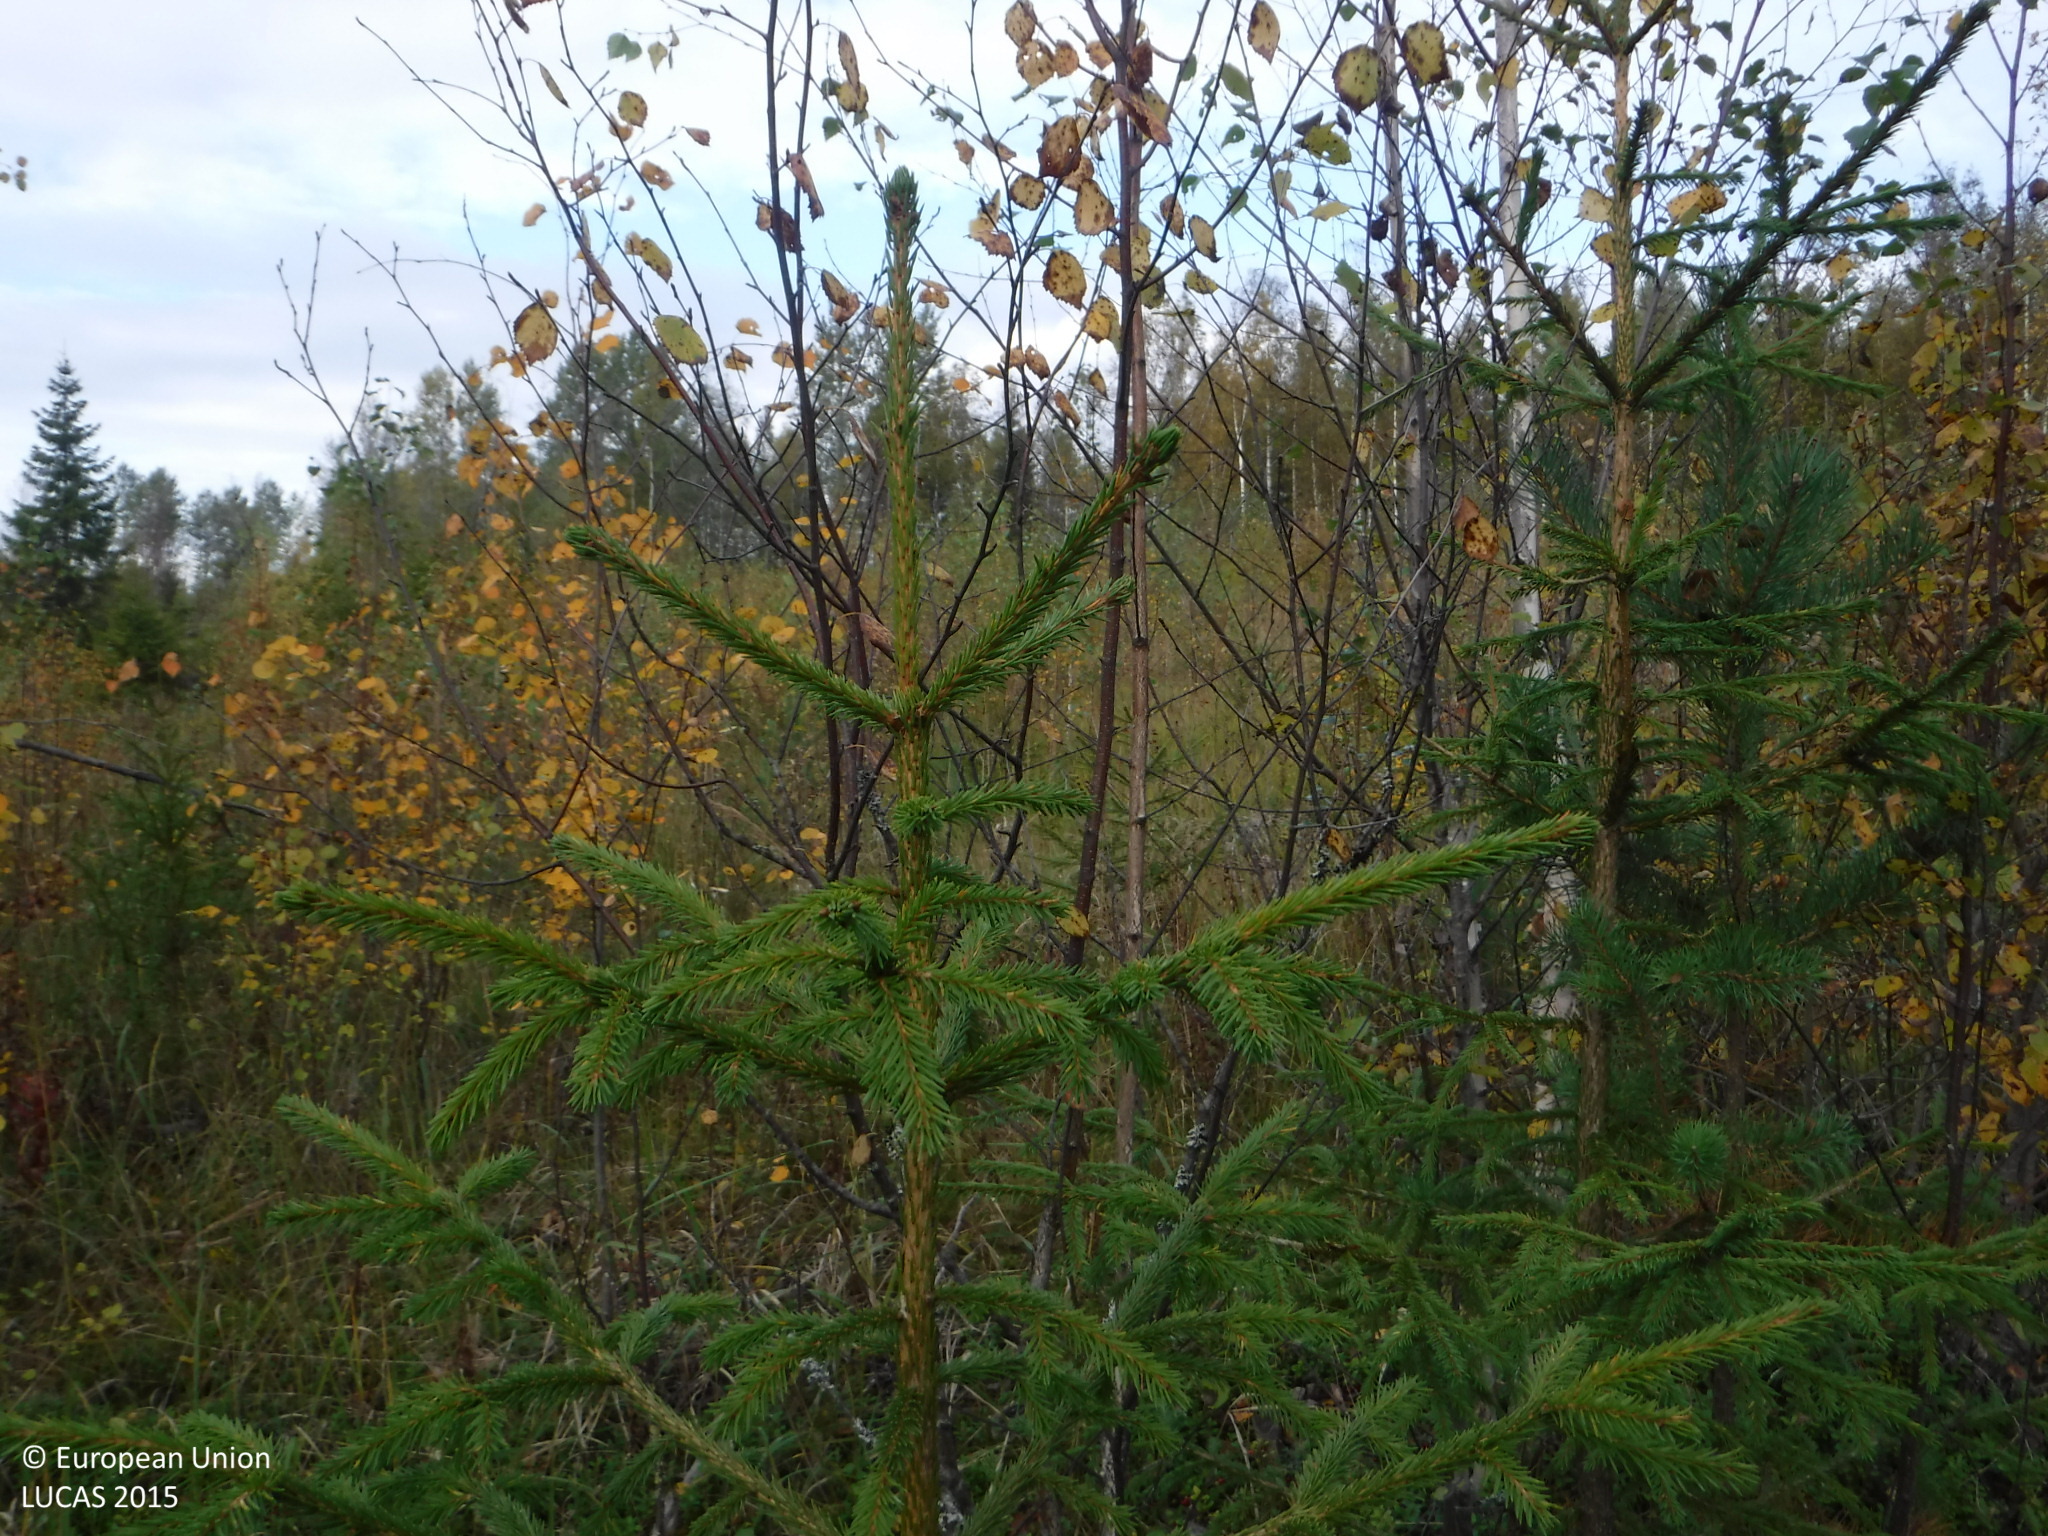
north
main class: Woodland
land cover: Spruce dominated mixed woodland
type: boreal forest
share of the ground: 50 - 75 %
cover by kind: coniferous forest trees 30 %, shrubs 30 %, broadleaved forest trees 20 %, lichens and mosses 20 %
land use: Forestry
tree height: < 5 m
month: September
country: FI
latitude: 62.1305
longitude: 23.2828
